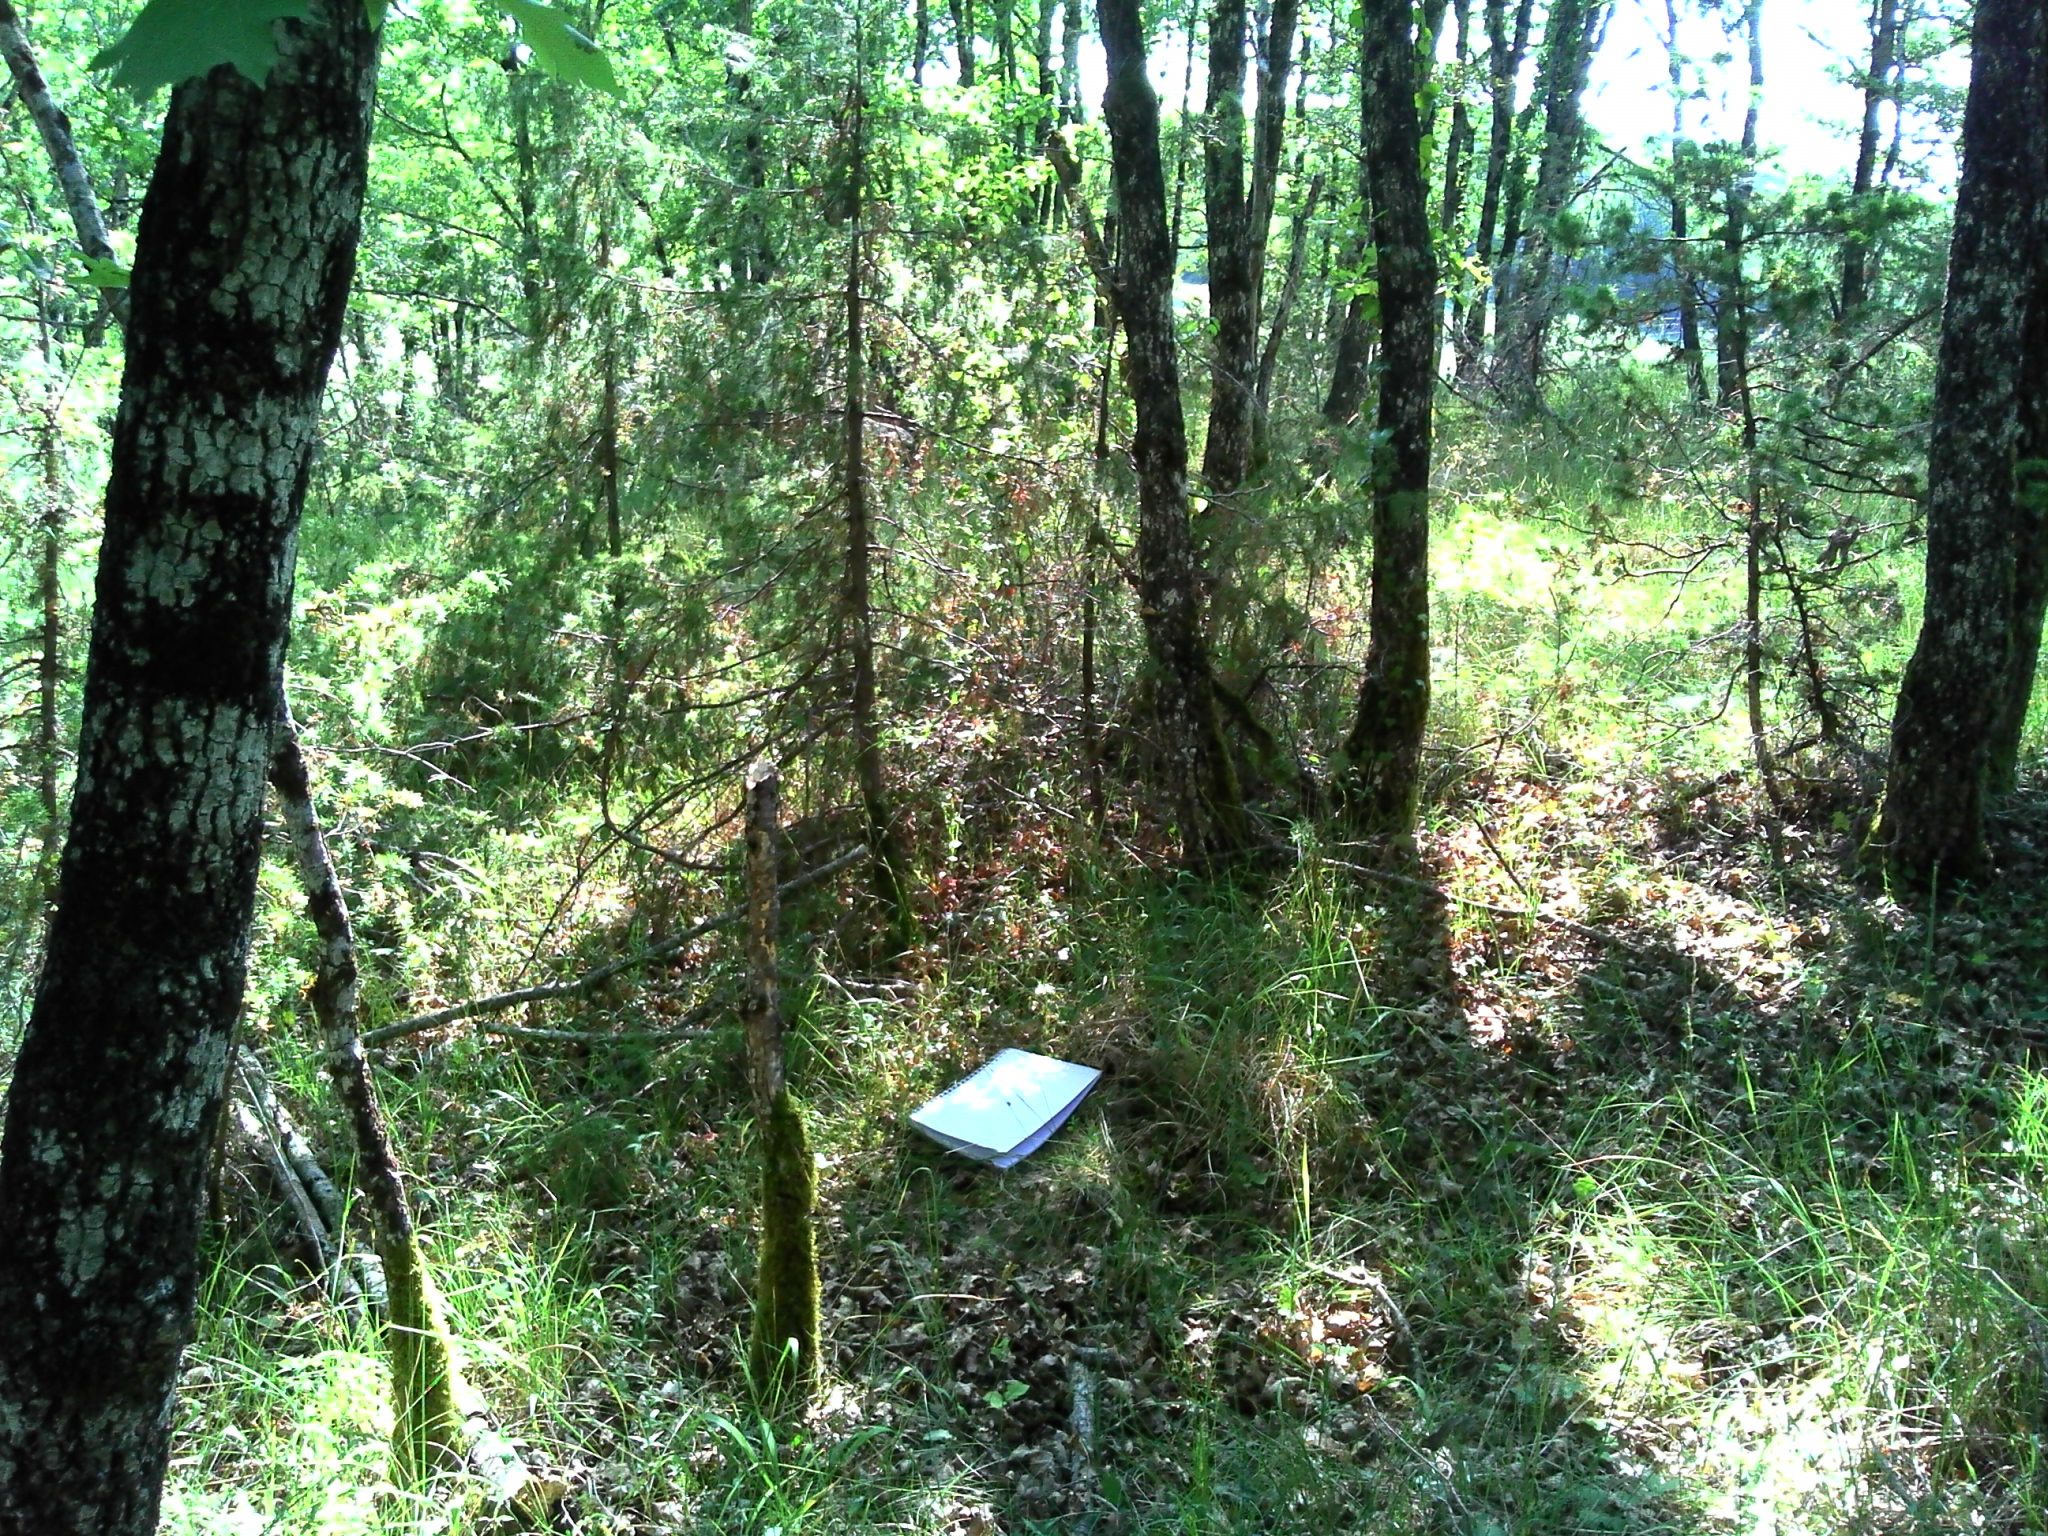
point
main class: Woodland
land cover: Broadleaved woodland
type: thermophilous deciduous forest
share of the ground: > 75 %
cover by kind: broadleaved forest trees 95 %, herbaceous plants 5 %
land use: Forestry
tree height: > 5 m
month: June
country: FR
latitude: 44.9748
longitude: 1.4364
